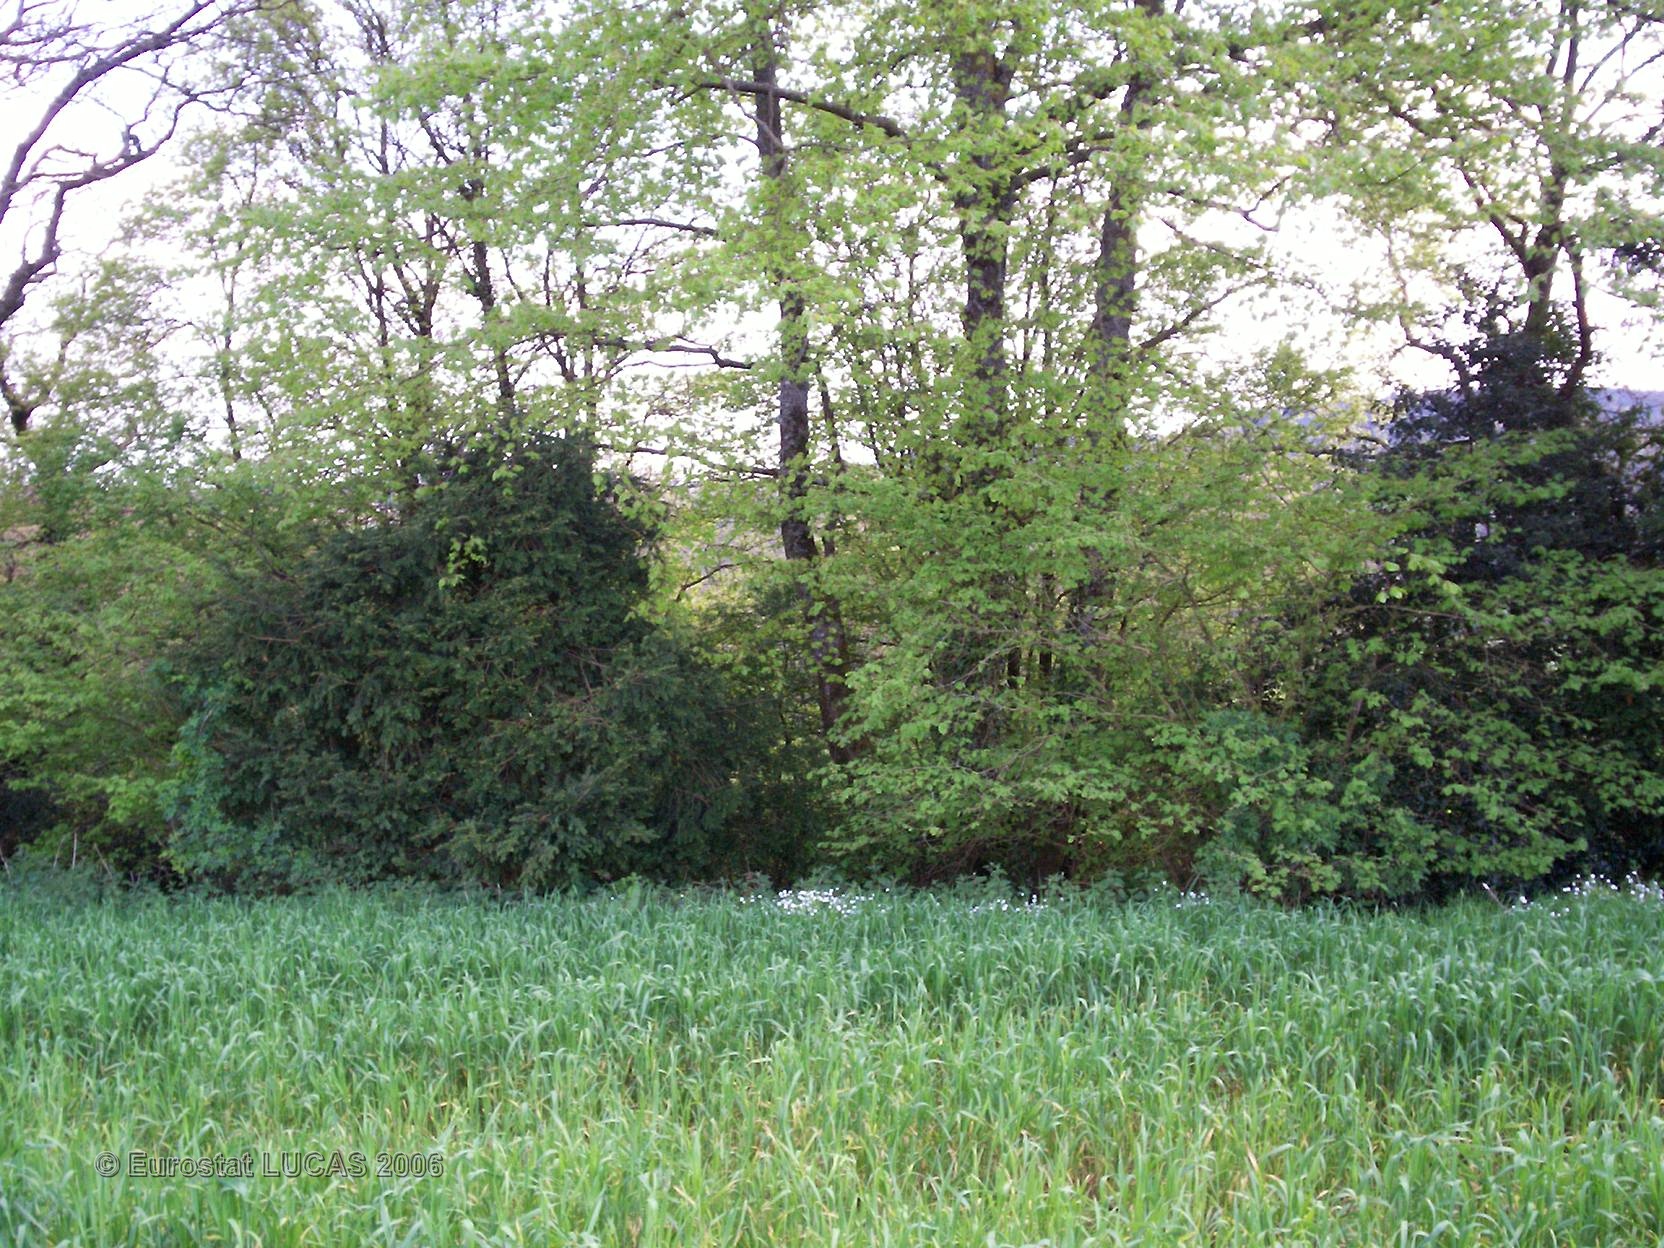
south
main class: Cropland
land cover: Barley
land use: Agriculture (excluding fallow land and kitchen gardens)
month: May
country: FR
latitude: 48.3909
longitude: -3.6537
